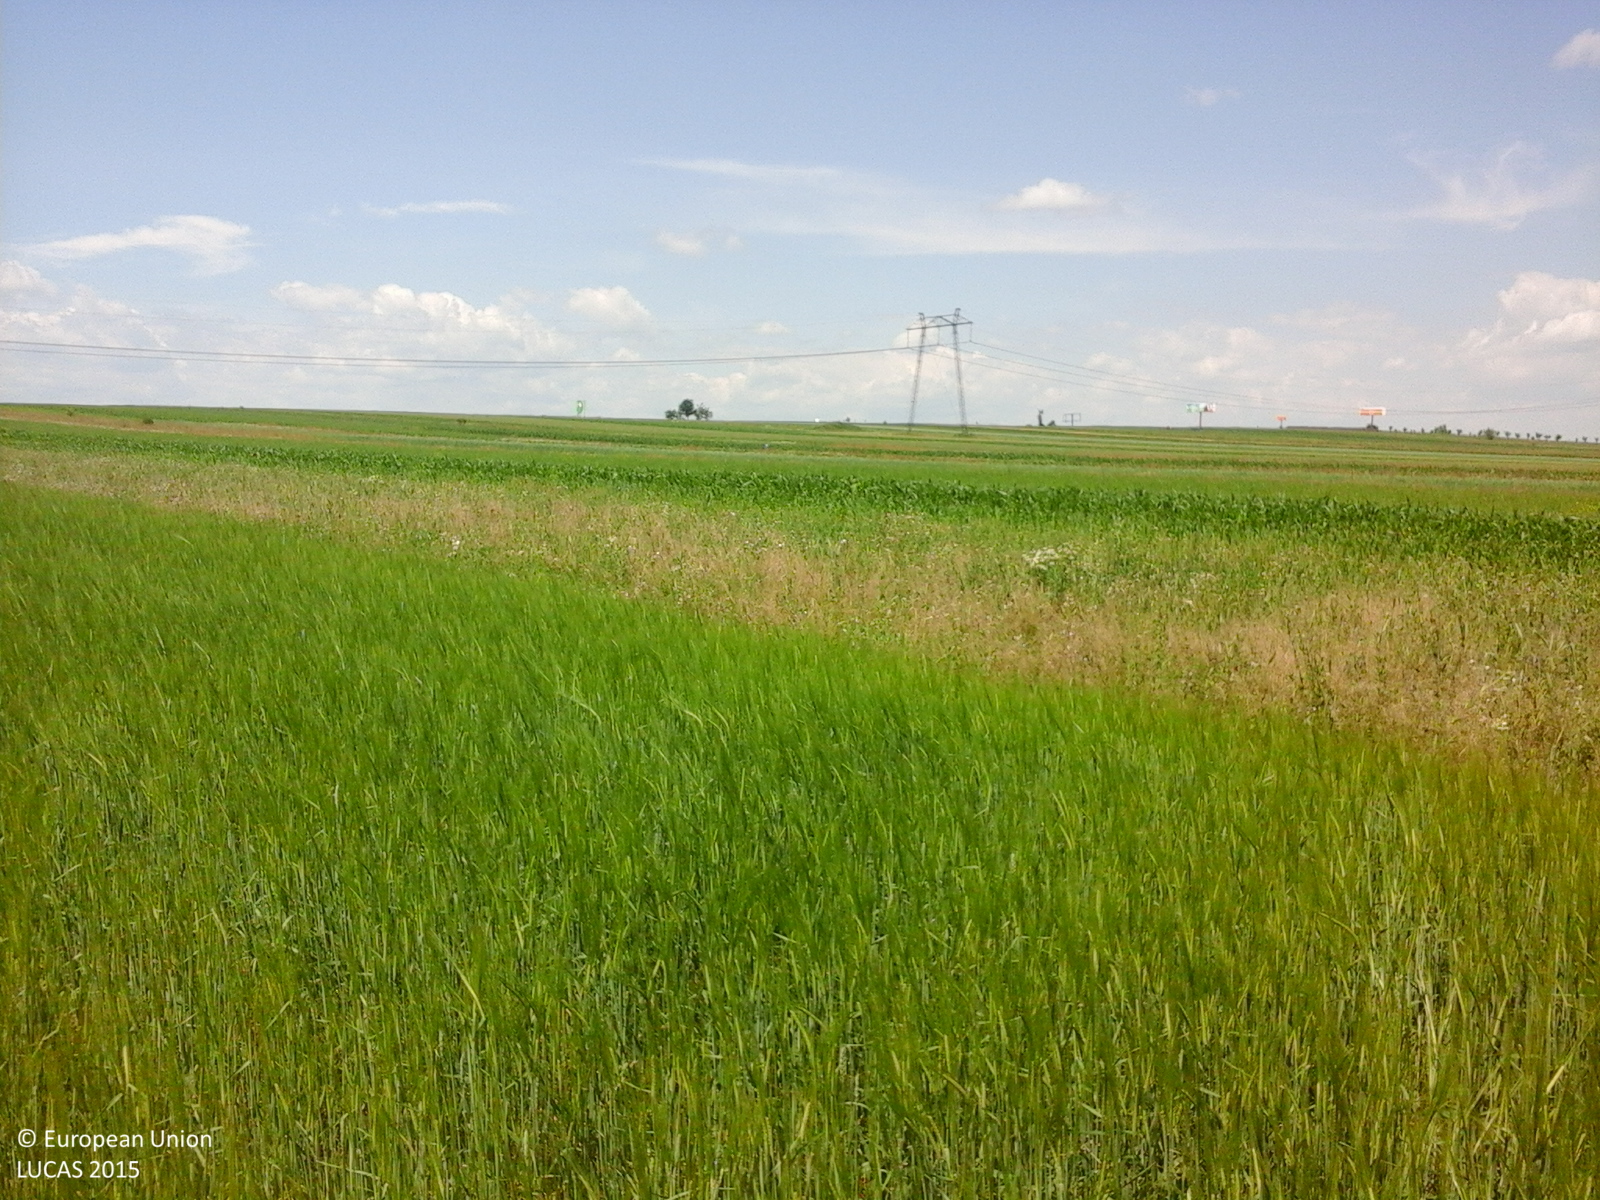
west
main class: Cropland
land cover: Barley
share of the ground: > 75 %
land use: Agriculture (excluding fallow land and kitchen gardens)
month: June
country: RO
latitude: 47.5918
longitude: 26.2672
